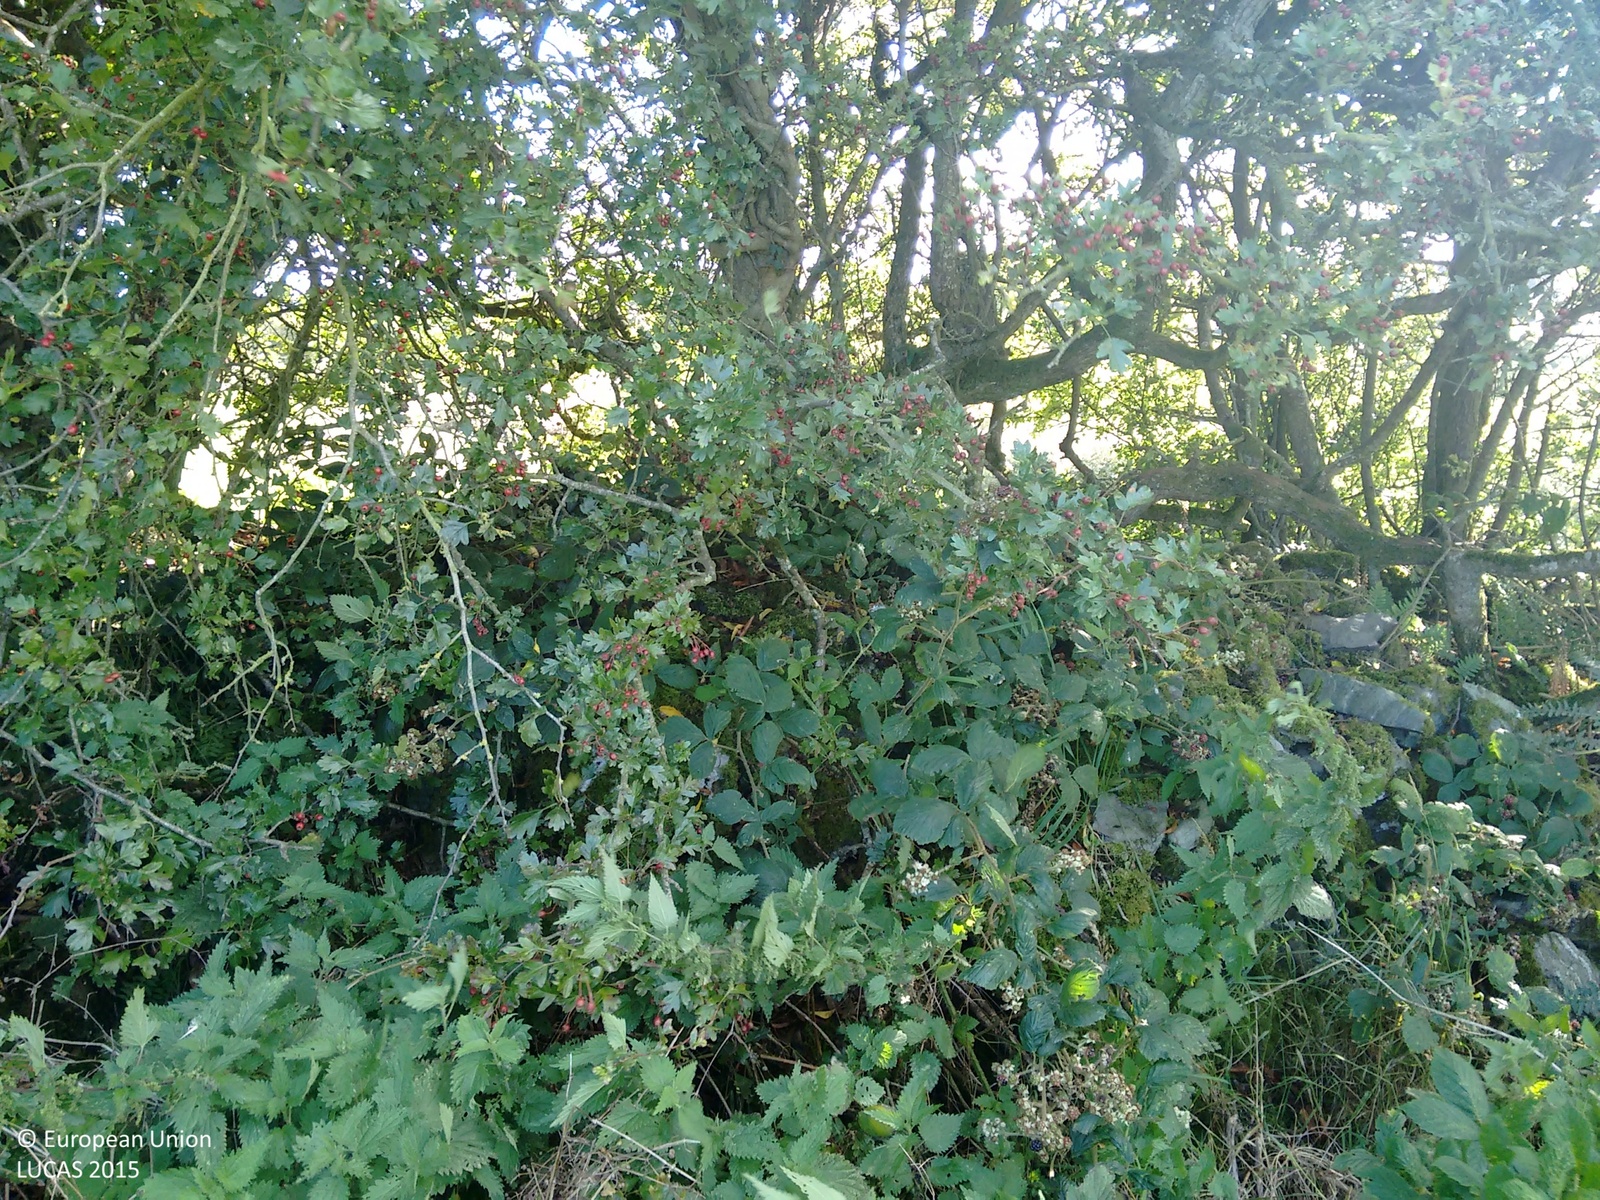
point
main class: Grassland
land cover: Grassland without tree/shrub cover
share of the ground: > 75 %
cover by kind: herbaceous plants 100 %
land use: Agriculture (excluding fallow land and kitchen gardens)
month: September
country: IE
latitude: 54.2168
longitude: -6.9622
